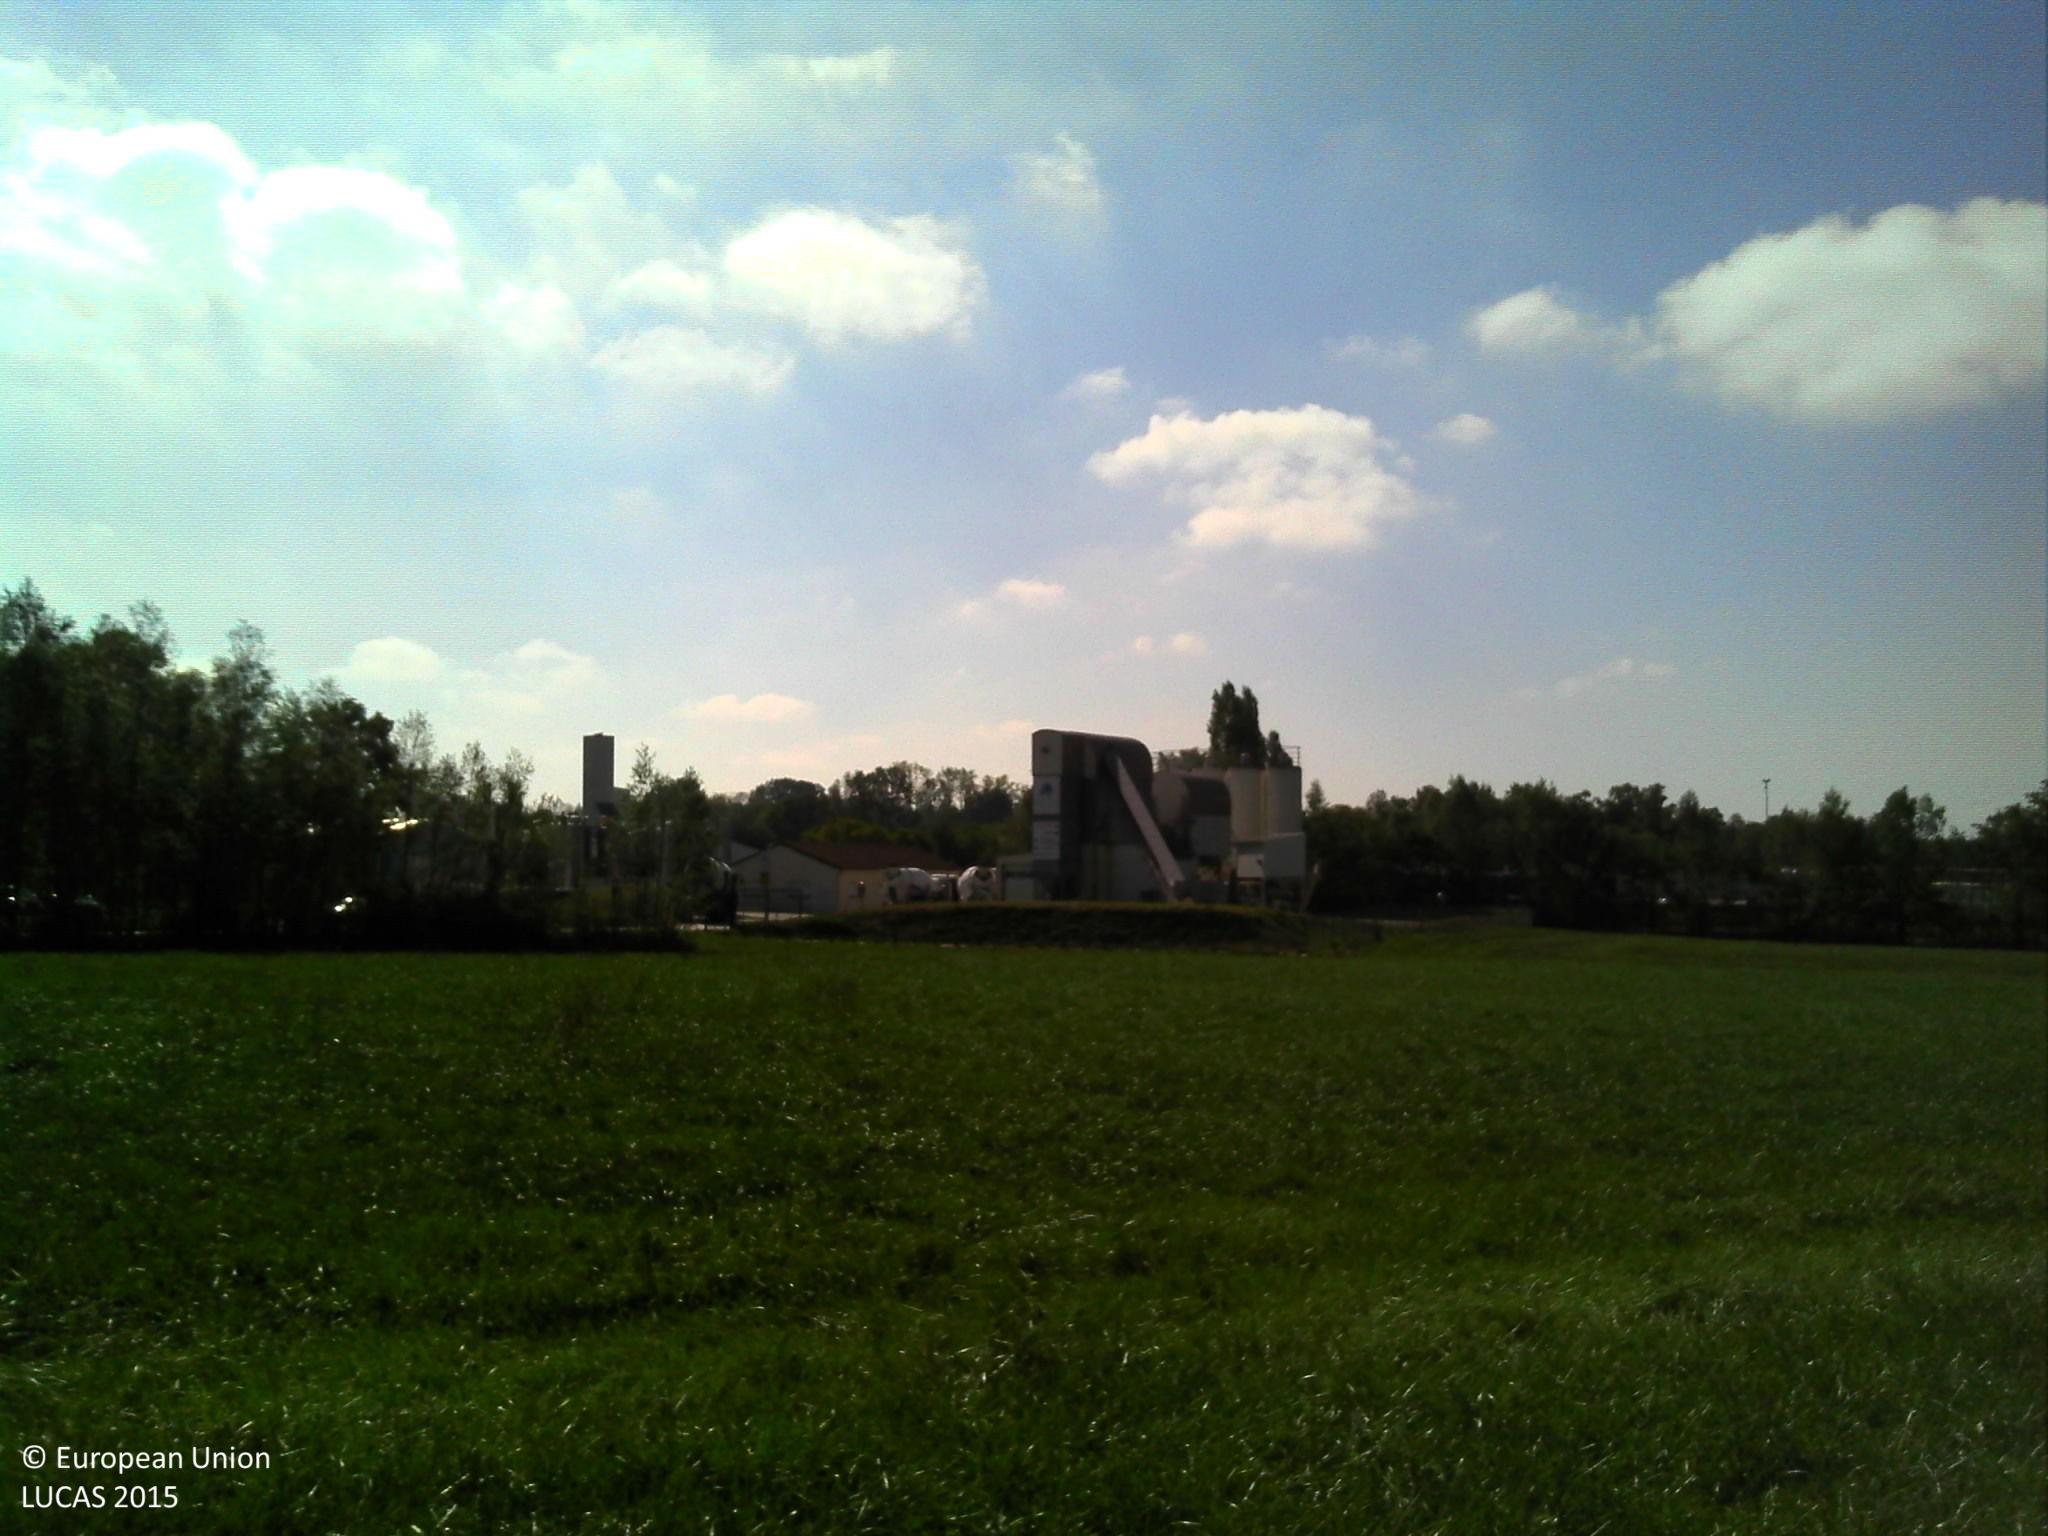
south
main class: Grassland
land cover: Grassland without tree/shrub cover
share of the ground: > 75 %
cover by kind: herbaceous plants 100 %
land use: Agriculture (excluding fallow land and kitchen gardens)
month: October
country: FR
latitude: 46.2838
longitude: 4.9017
